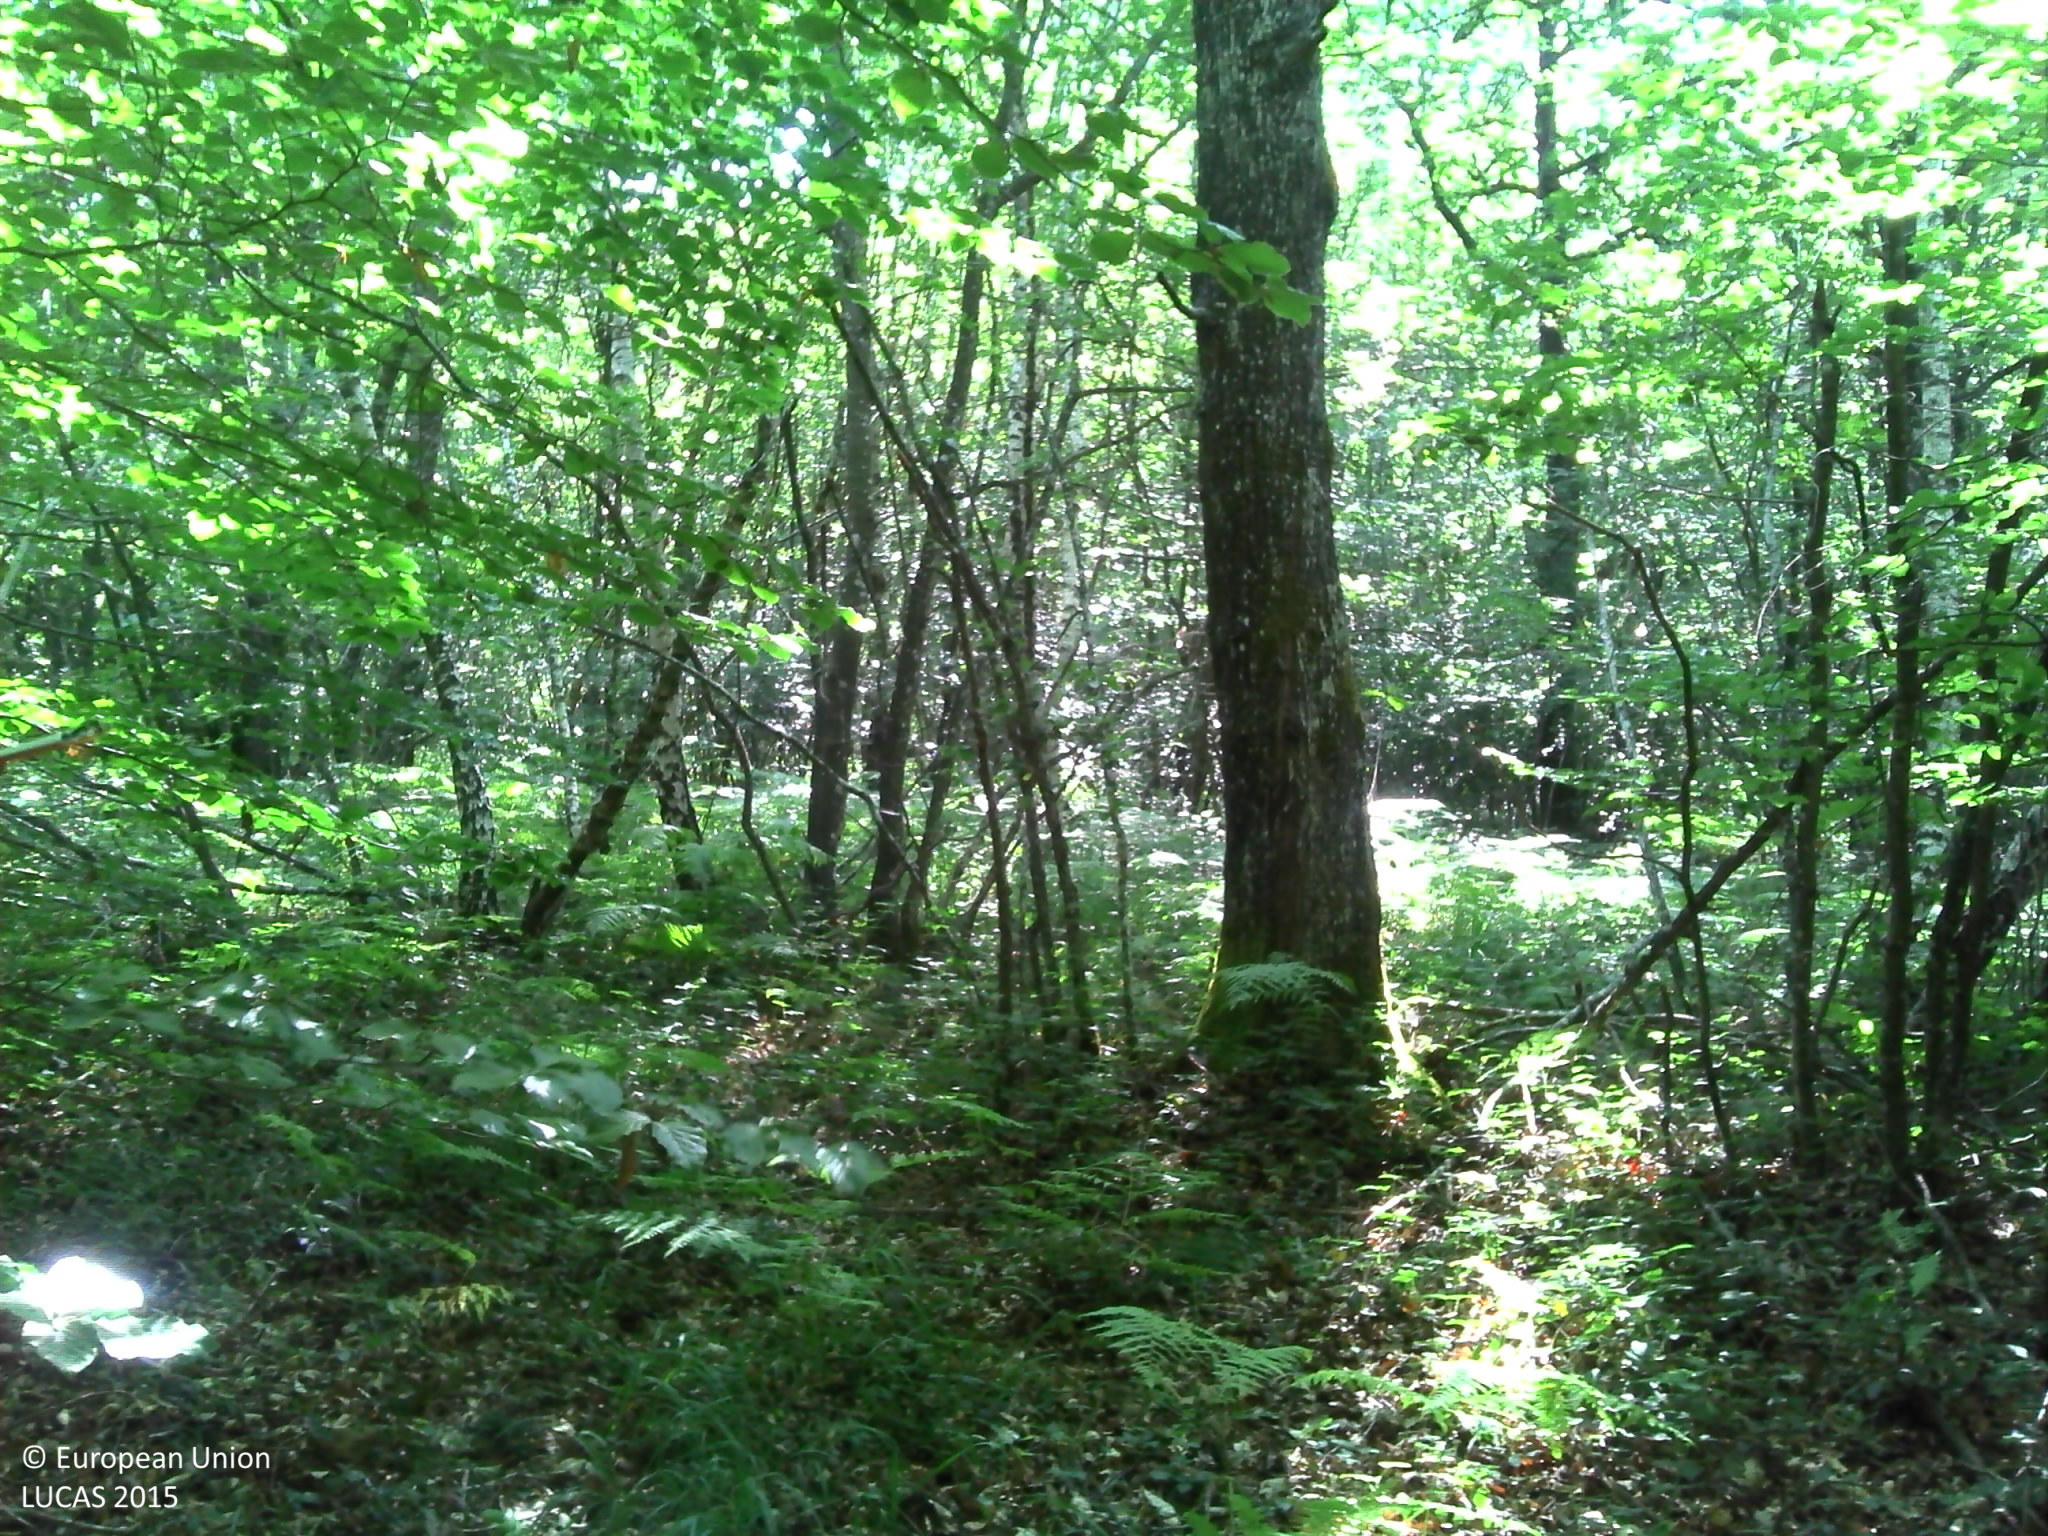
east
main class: Woodland
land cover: Broadleaved woodland
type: beech forest
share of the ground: > 75 %
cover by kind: broadleaved forest trees 90 %, herbaceous plants 5 %, consolidated bare surface 5 %
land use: Forestry
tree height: > 5 m
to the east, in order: Broadleaved woodland; Tracks; Broadleaved woodland
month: July
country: FR
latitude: 45.4284
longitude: 5.1349
